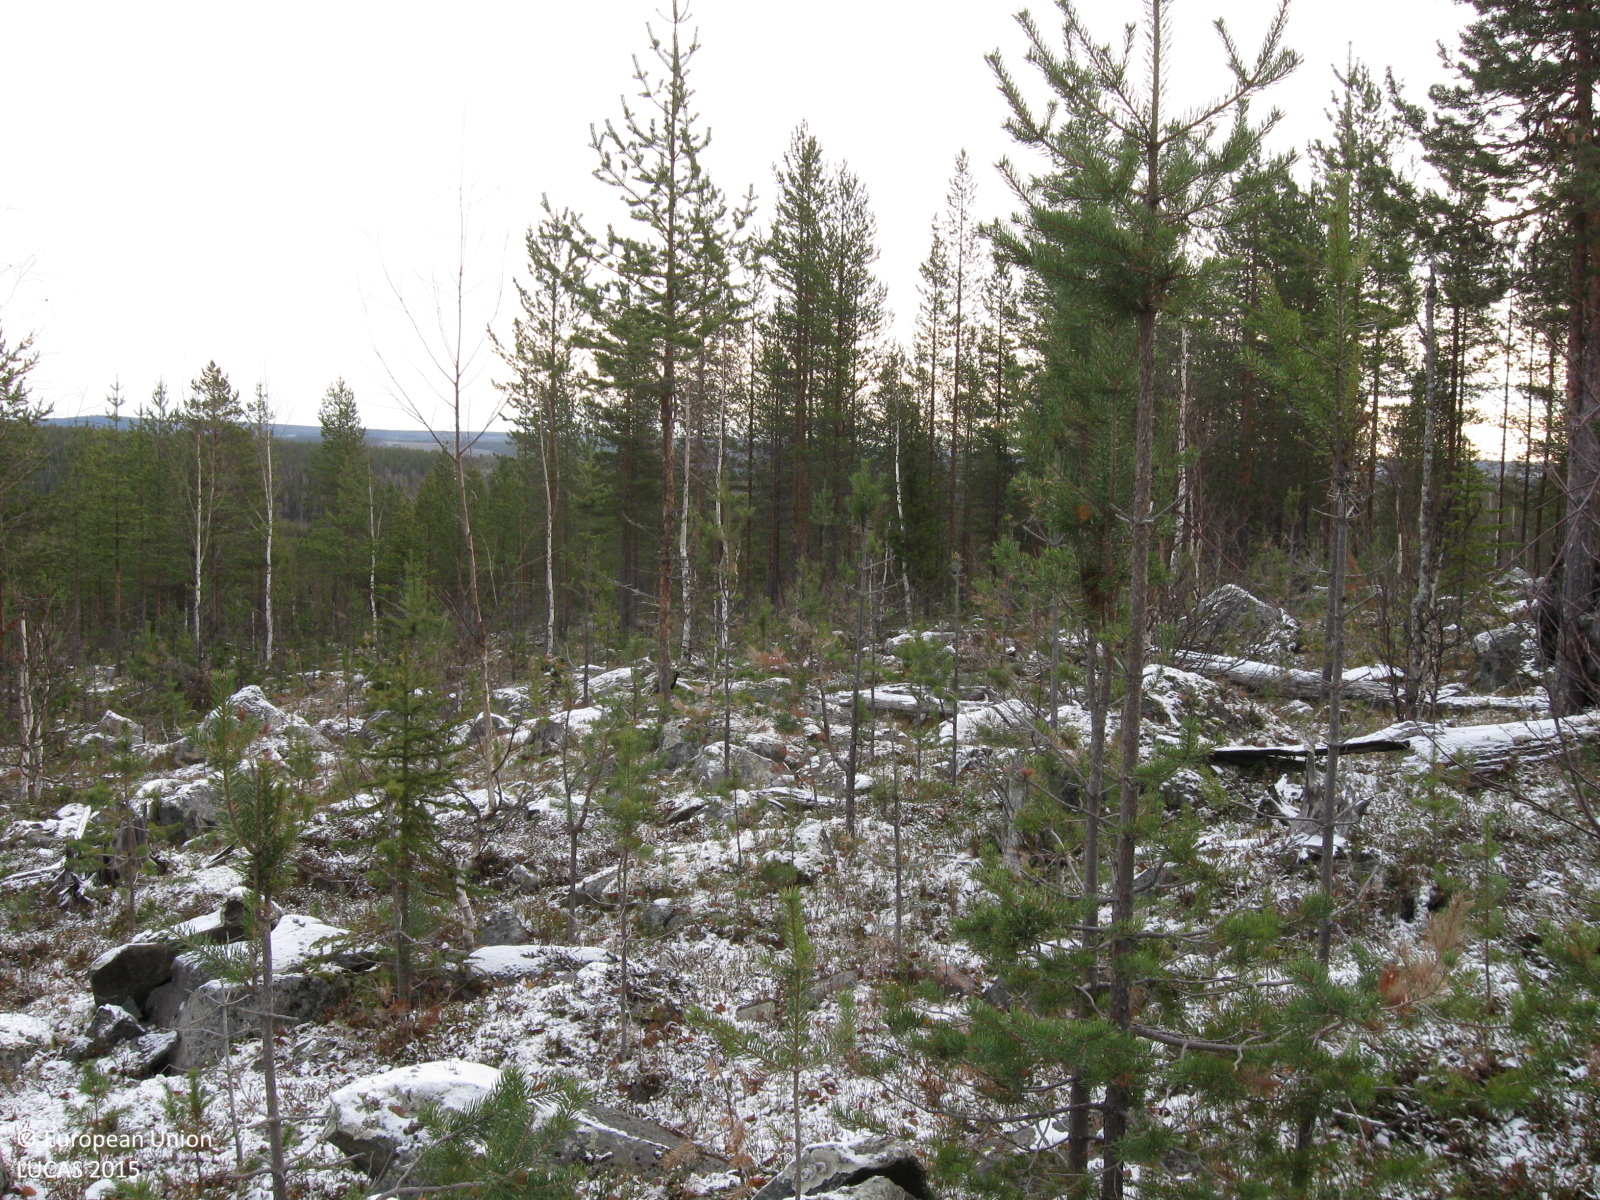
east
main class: Woodland
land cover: Pine dominated mixed woodland
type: boreal forest
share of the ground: 25 - 50 %
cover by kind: unconsolidated bare surface 35 %, coniferous forest trees 15 %, broadleaved forest trees 15 %, shrubs 15 %, herbaceous plants 10 %, lichens and mosses 10 %
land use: Forestry
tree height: < 5 m
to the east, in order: Pine dominated mixed woodland; Pine dominated coniferous woodland
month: October
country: SE
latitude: 66.2361
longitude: 21.6872
